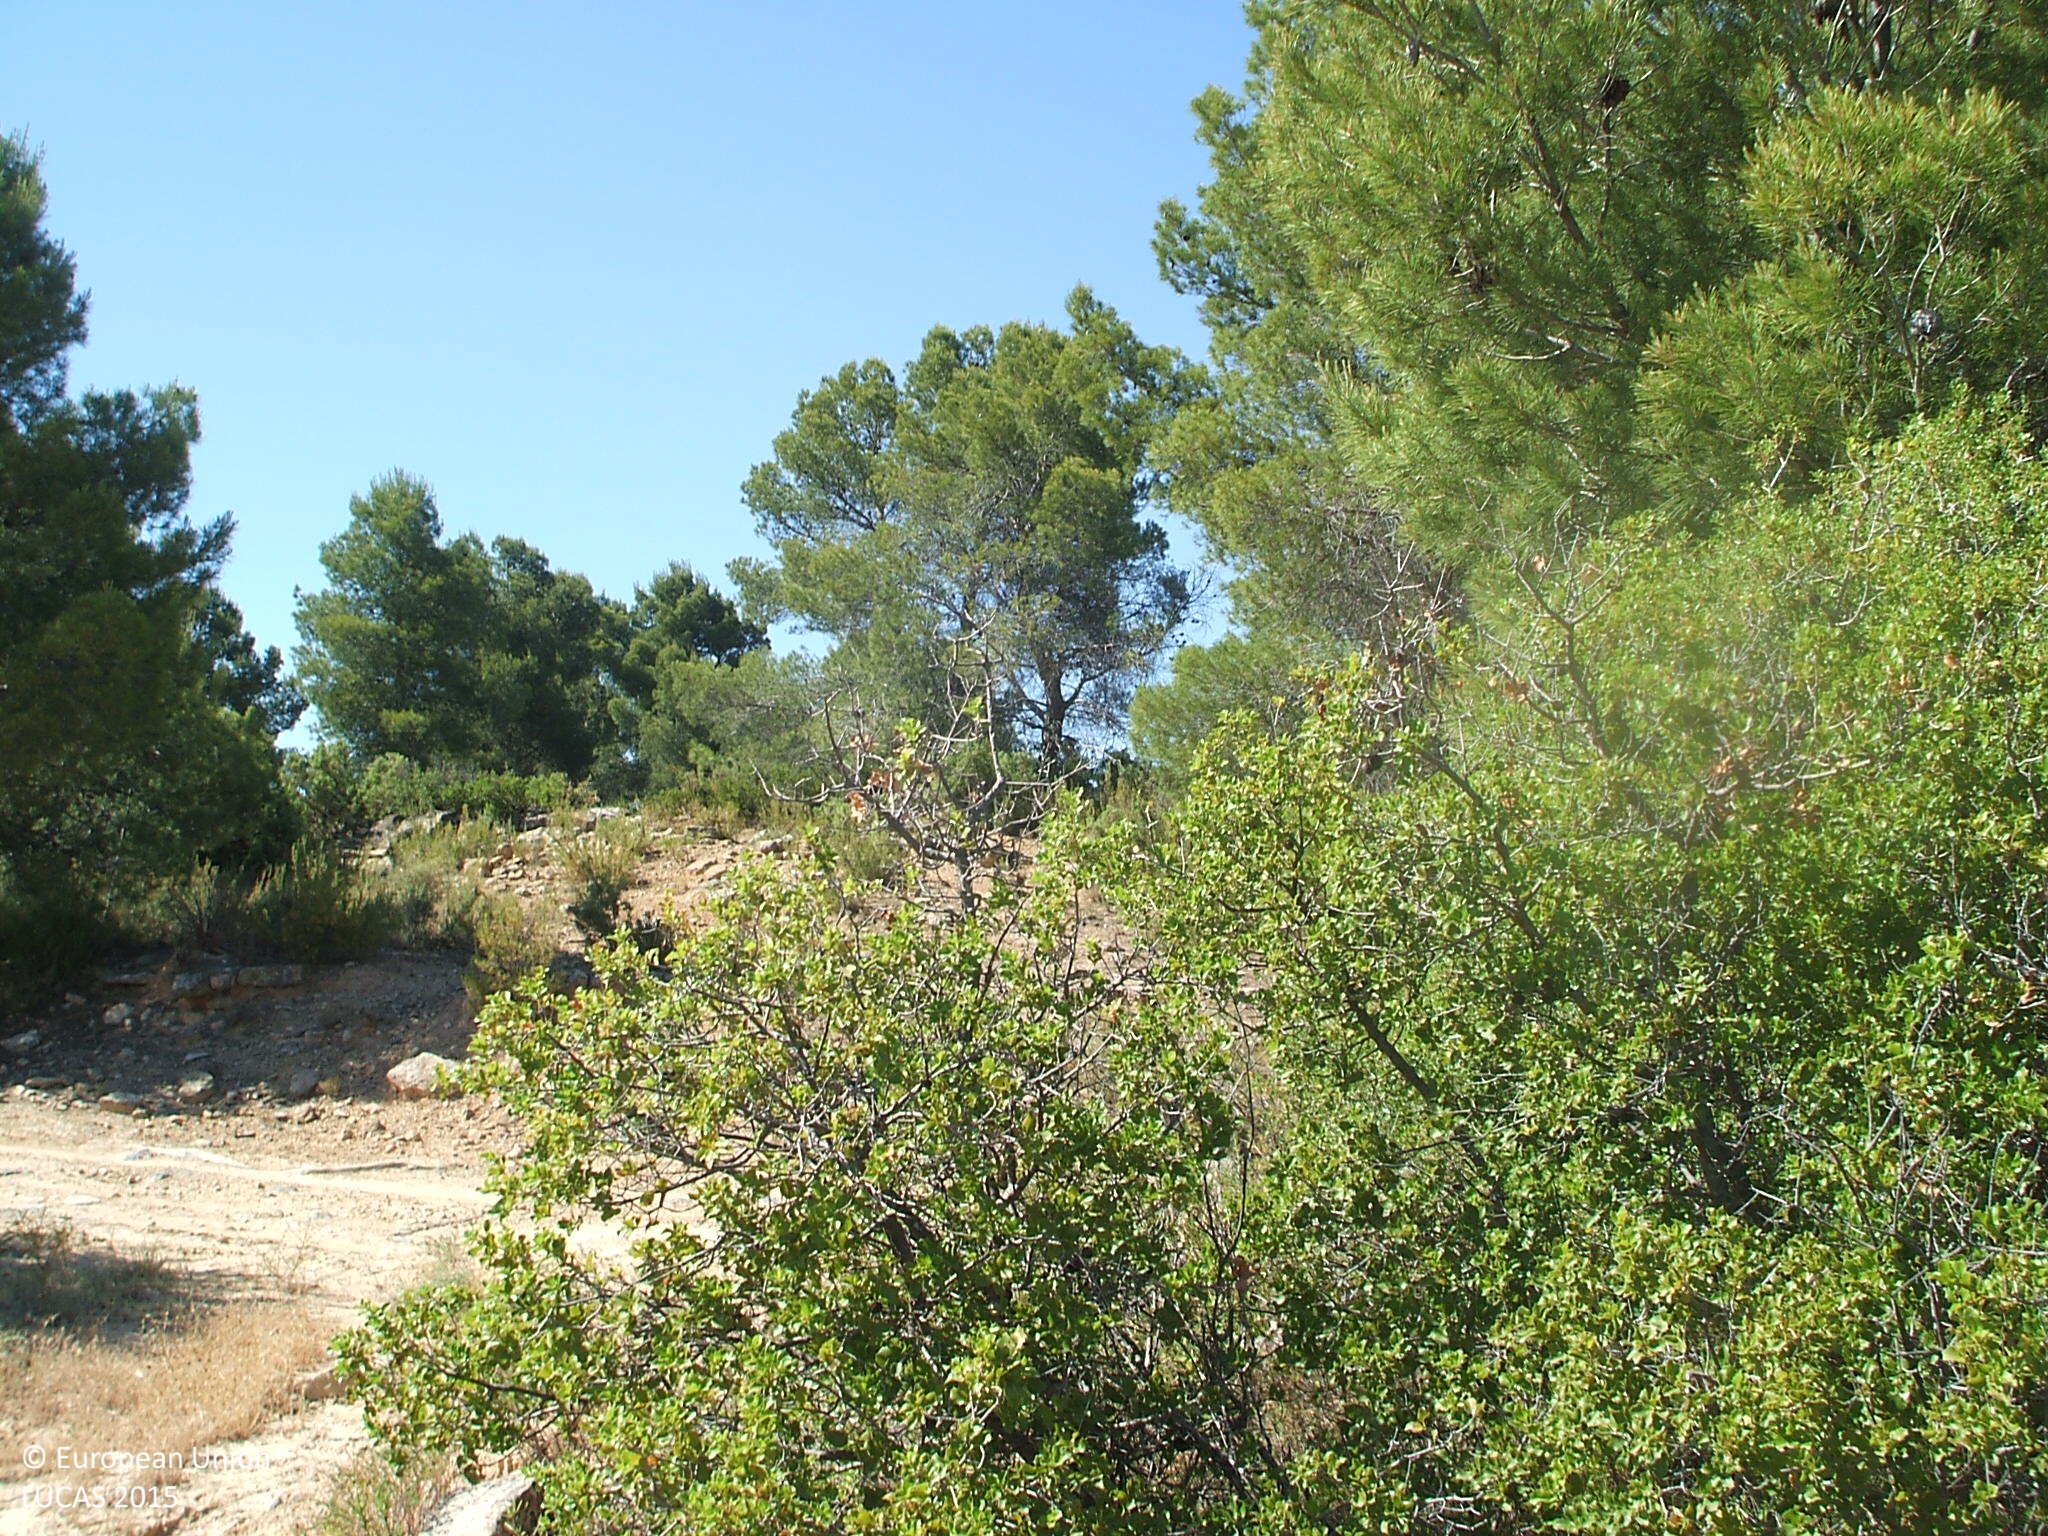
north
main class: Shrubland
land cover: Shrubland with sparse tree cover
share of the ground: 10 - 25 %
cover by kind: herbaceous plants 75 %, shrubs 20 %, coniferous forest trees 5 %
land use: Semi-natural and natural areas not in use
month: June
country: ES
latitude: 40.9891
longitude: 0.1366
